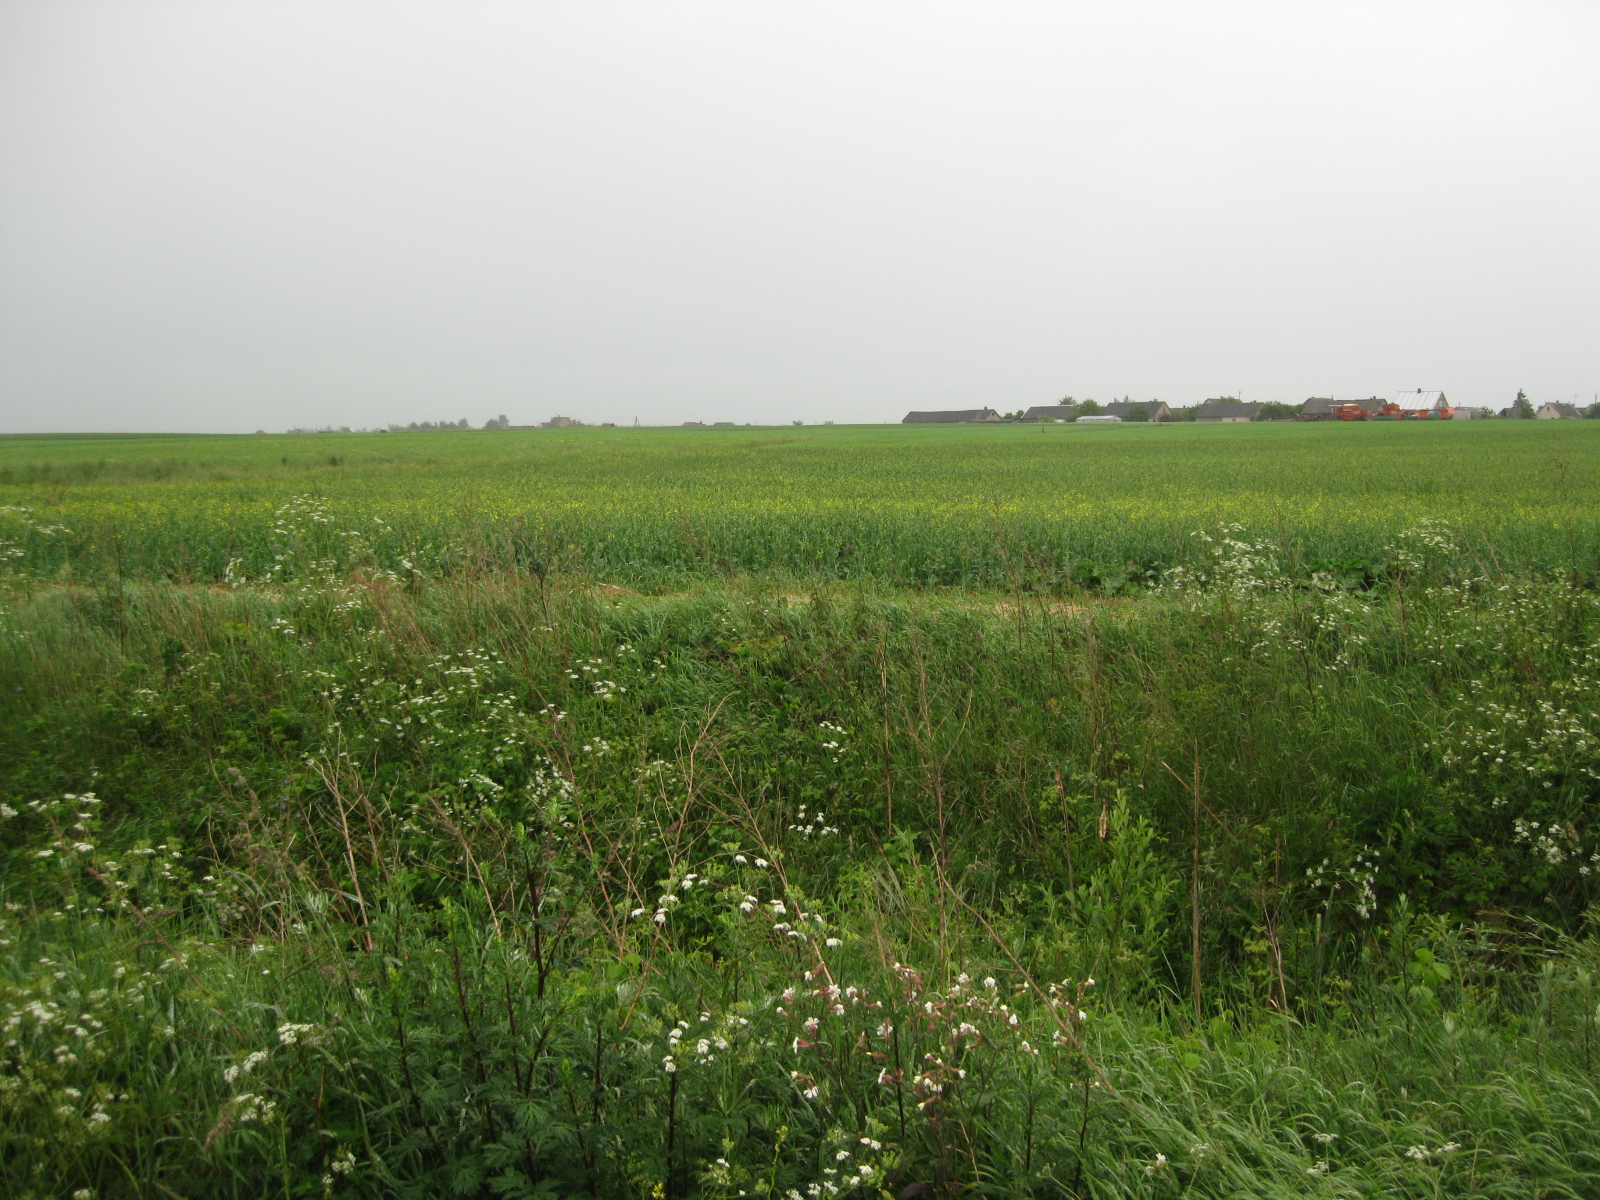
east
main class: Cropland
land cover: Rape and turnip rape
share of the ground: > 75 %
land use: Agriculture (excluding fallow land and kitchen gardens)
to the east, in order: Rape and turnip rape; Grassland with sparse tree/shrub cover; Ditches and canals; Spontaneously vegetated surfaces; Rape and turnip rape; Grass margins; Tracks; Grassland without tree/shrub cover; Barley; Common wheat
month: June
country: LT
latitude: 55.4878
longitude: 23.8385
